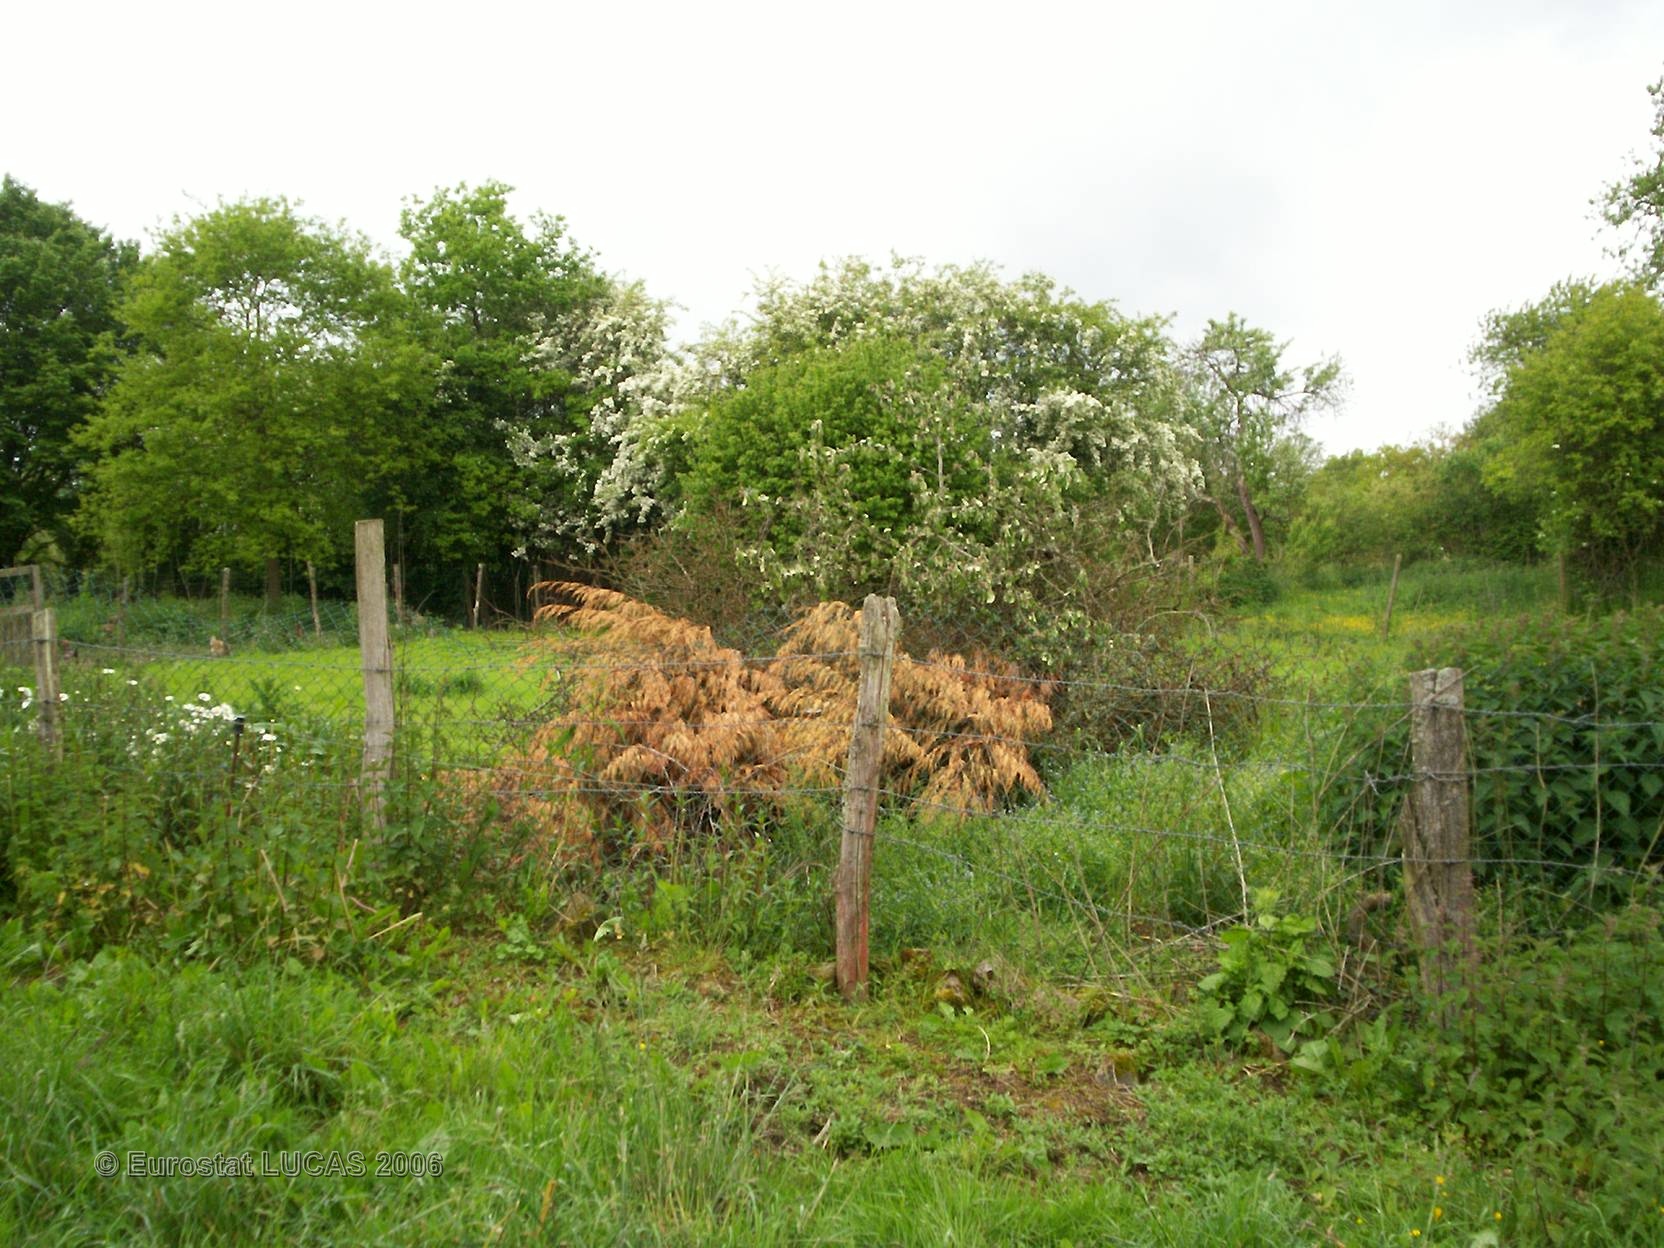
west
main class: Grassland
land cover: Grassland with sparse tree/shrub cover
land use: Agriculture (excluding fallow land and kitchen gardens)
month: May
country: FR
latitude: 48.6612
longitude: -0.3383
